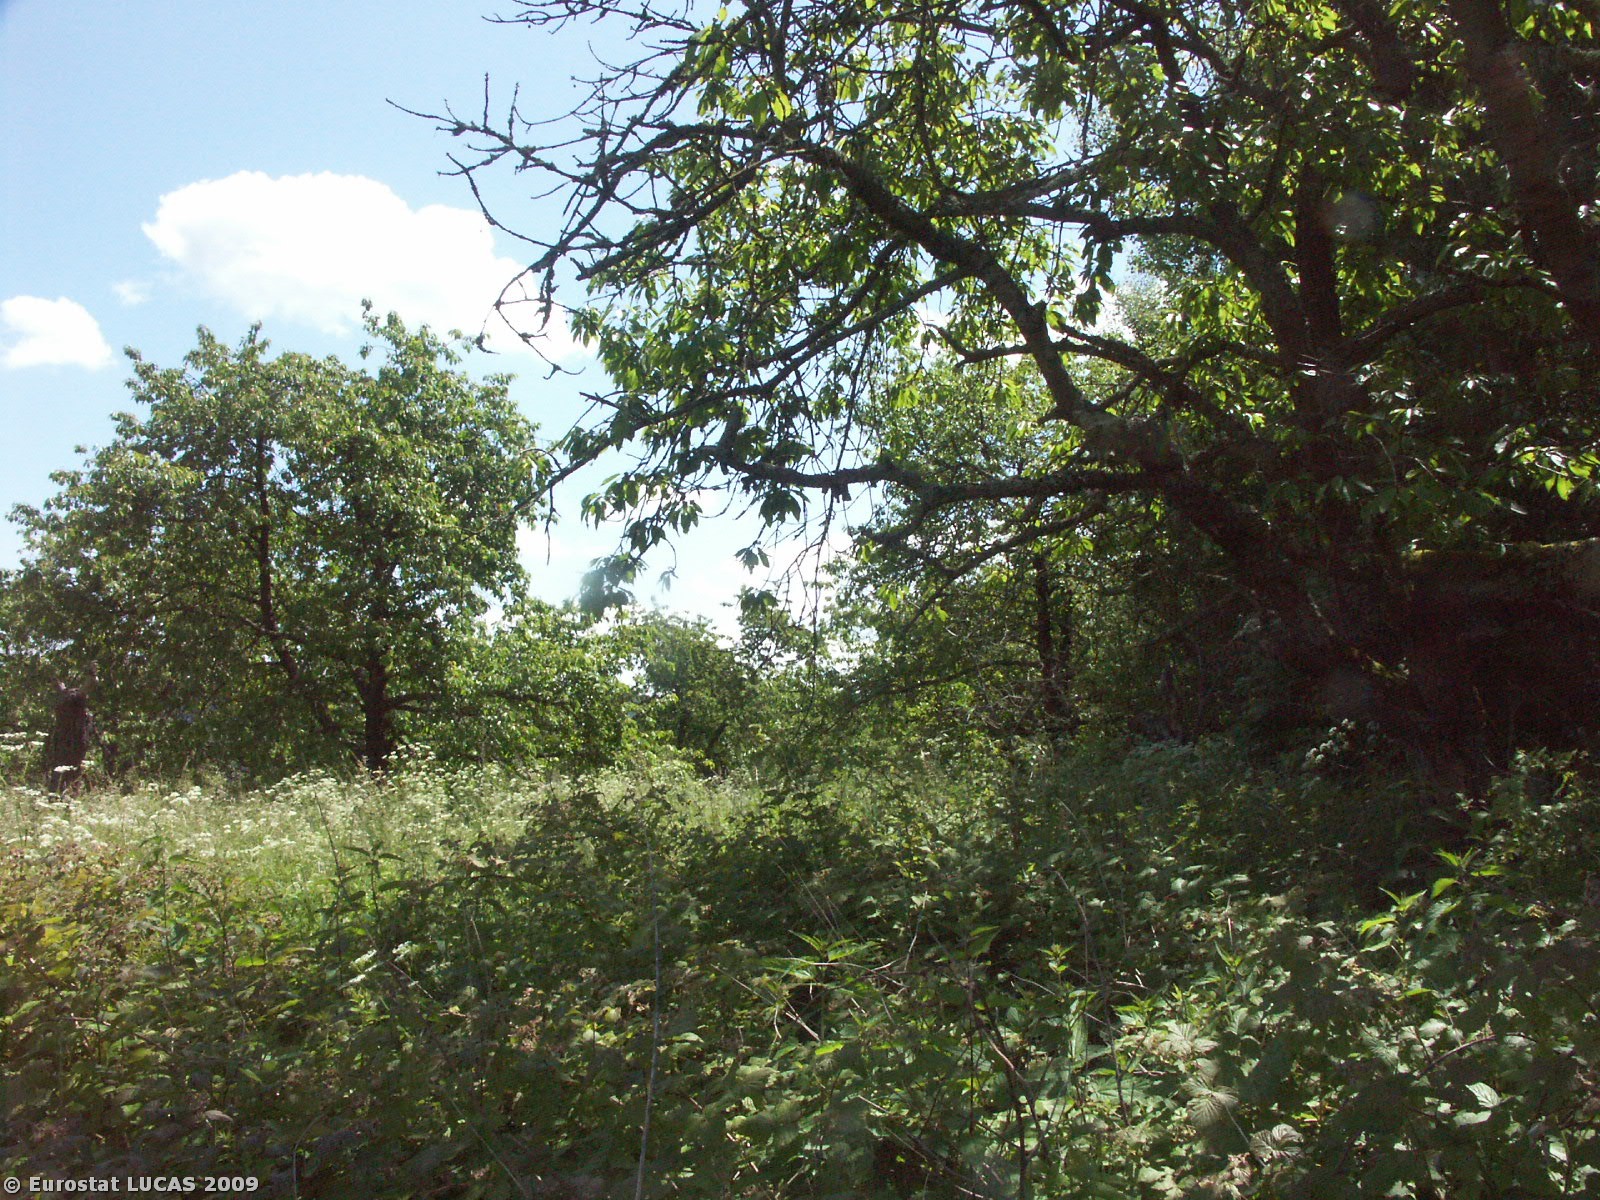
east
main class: Cropland
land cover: Cherry fruit
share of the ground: 10 - 25 %
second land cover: Shrubland with sparse tree cover
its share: > 75 %
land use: Agriculture (excluding fallow land and kitchen gardens)
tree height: > 5 m
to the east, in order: Cherry fruit; Shrubland with sparse tree cover; Tracks; Cherry fruit; Grassland with sparse tree/shrub cover; Grassland without tree/shrub cover
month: June
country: CZ
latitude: 48.8068
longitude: 14.2897
